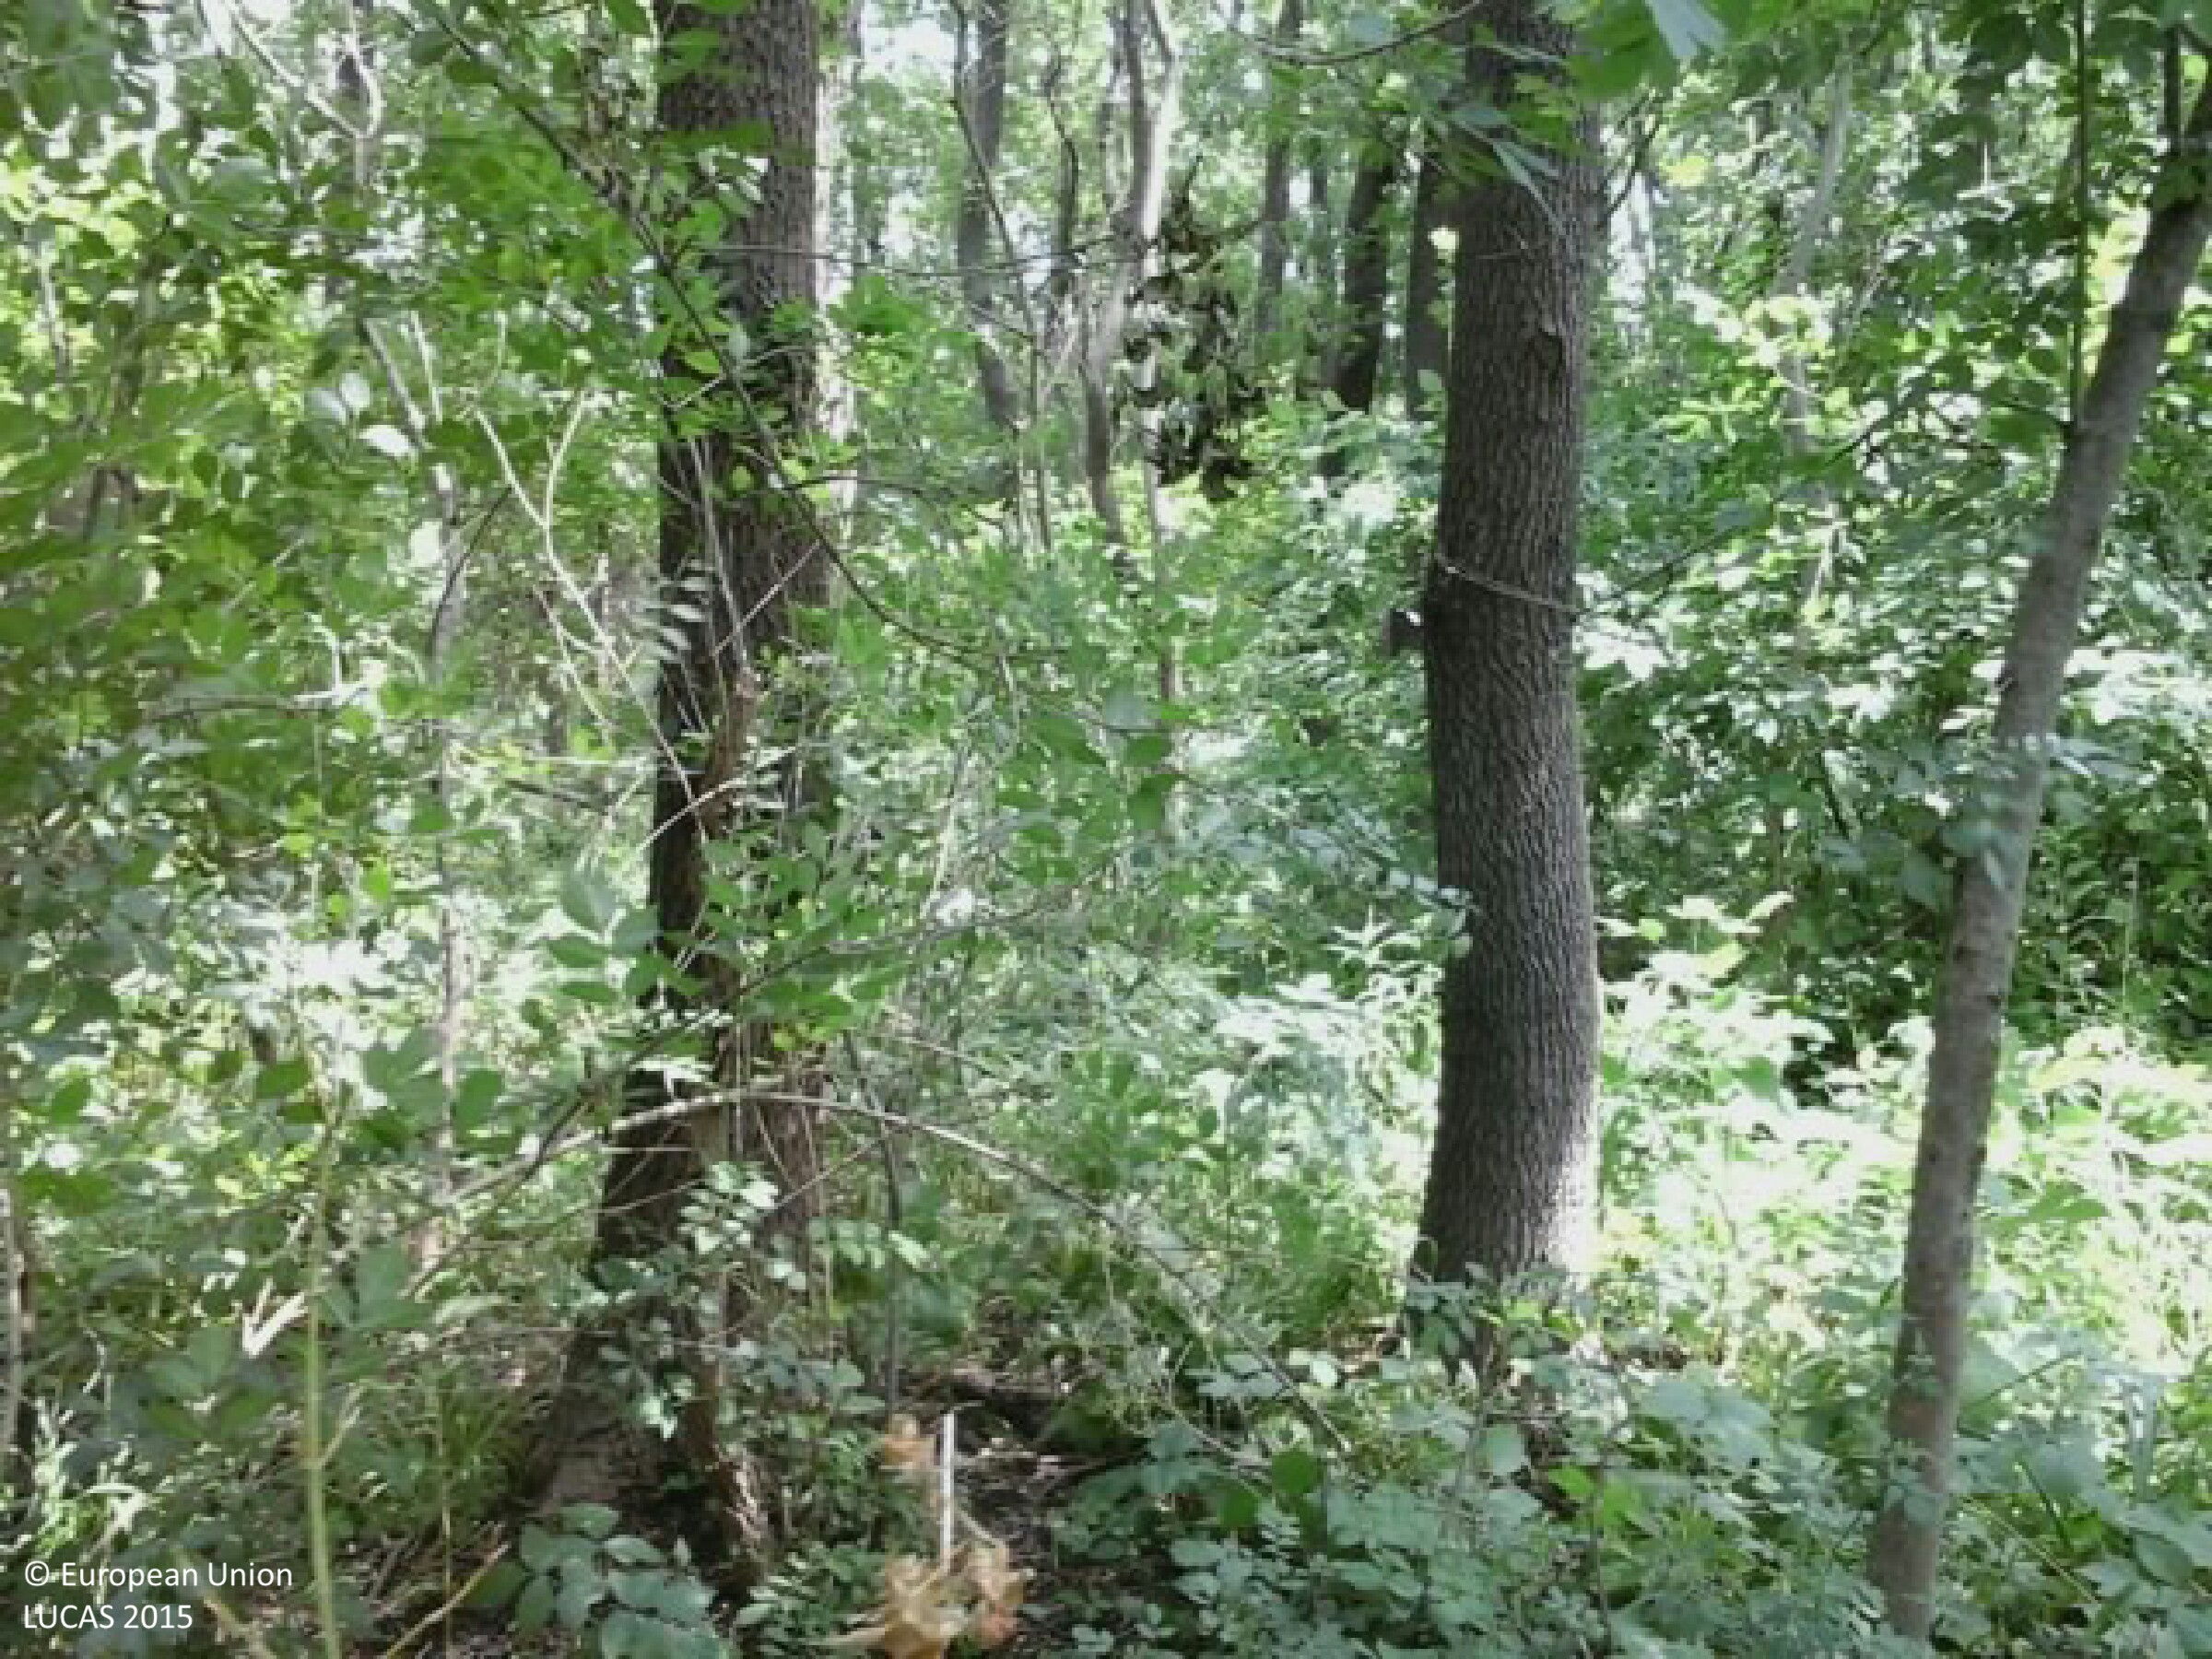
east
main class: Woodland
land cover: Broadleaved woodland
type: thermophilous deciduous forest
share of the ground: > 75 %
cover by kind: broadleaved forest trees 85 %, shrubs 10 %, herbaceous plants 5 %
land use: Forestry
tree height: > 5 m
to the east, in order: Broadleaved woodland; Shrubland without tree cover; Broadleaved woodland
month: July
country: HU
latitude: 47.2539
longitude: 19.2549
